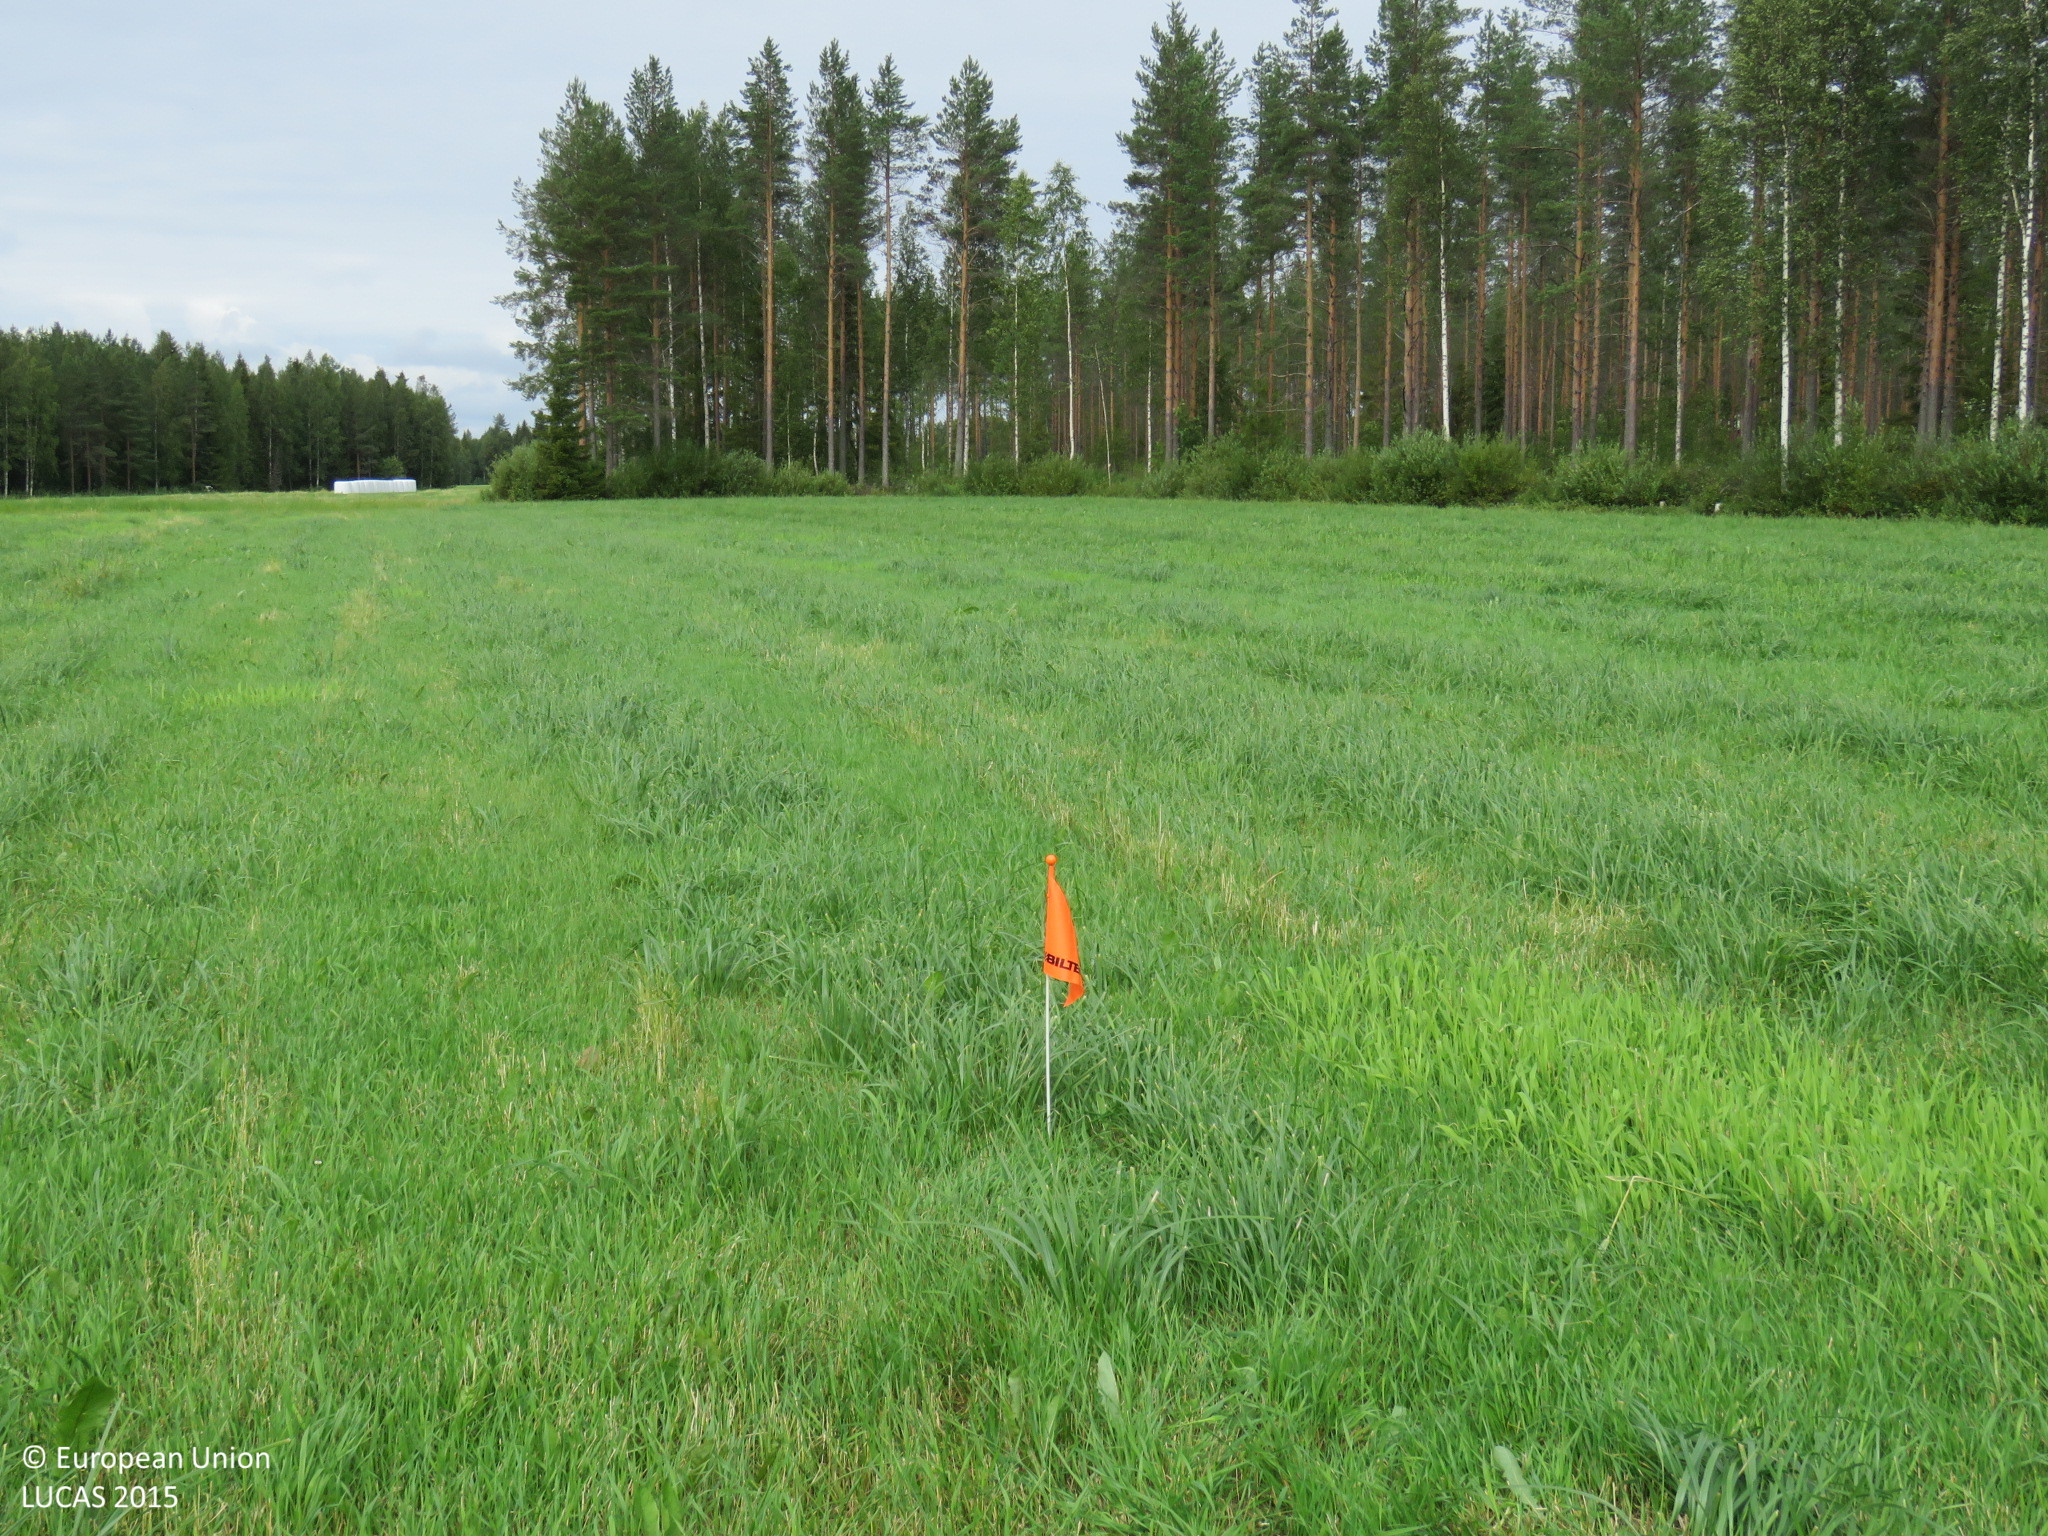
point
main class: Cropland
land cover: Temporary grasslands
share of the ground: > 75 %
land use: Agriculture (excluding fallow land and kitchen gardens)
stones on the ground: < 10 %
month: July
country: FI
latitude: 64.6085
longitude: 26.7791
